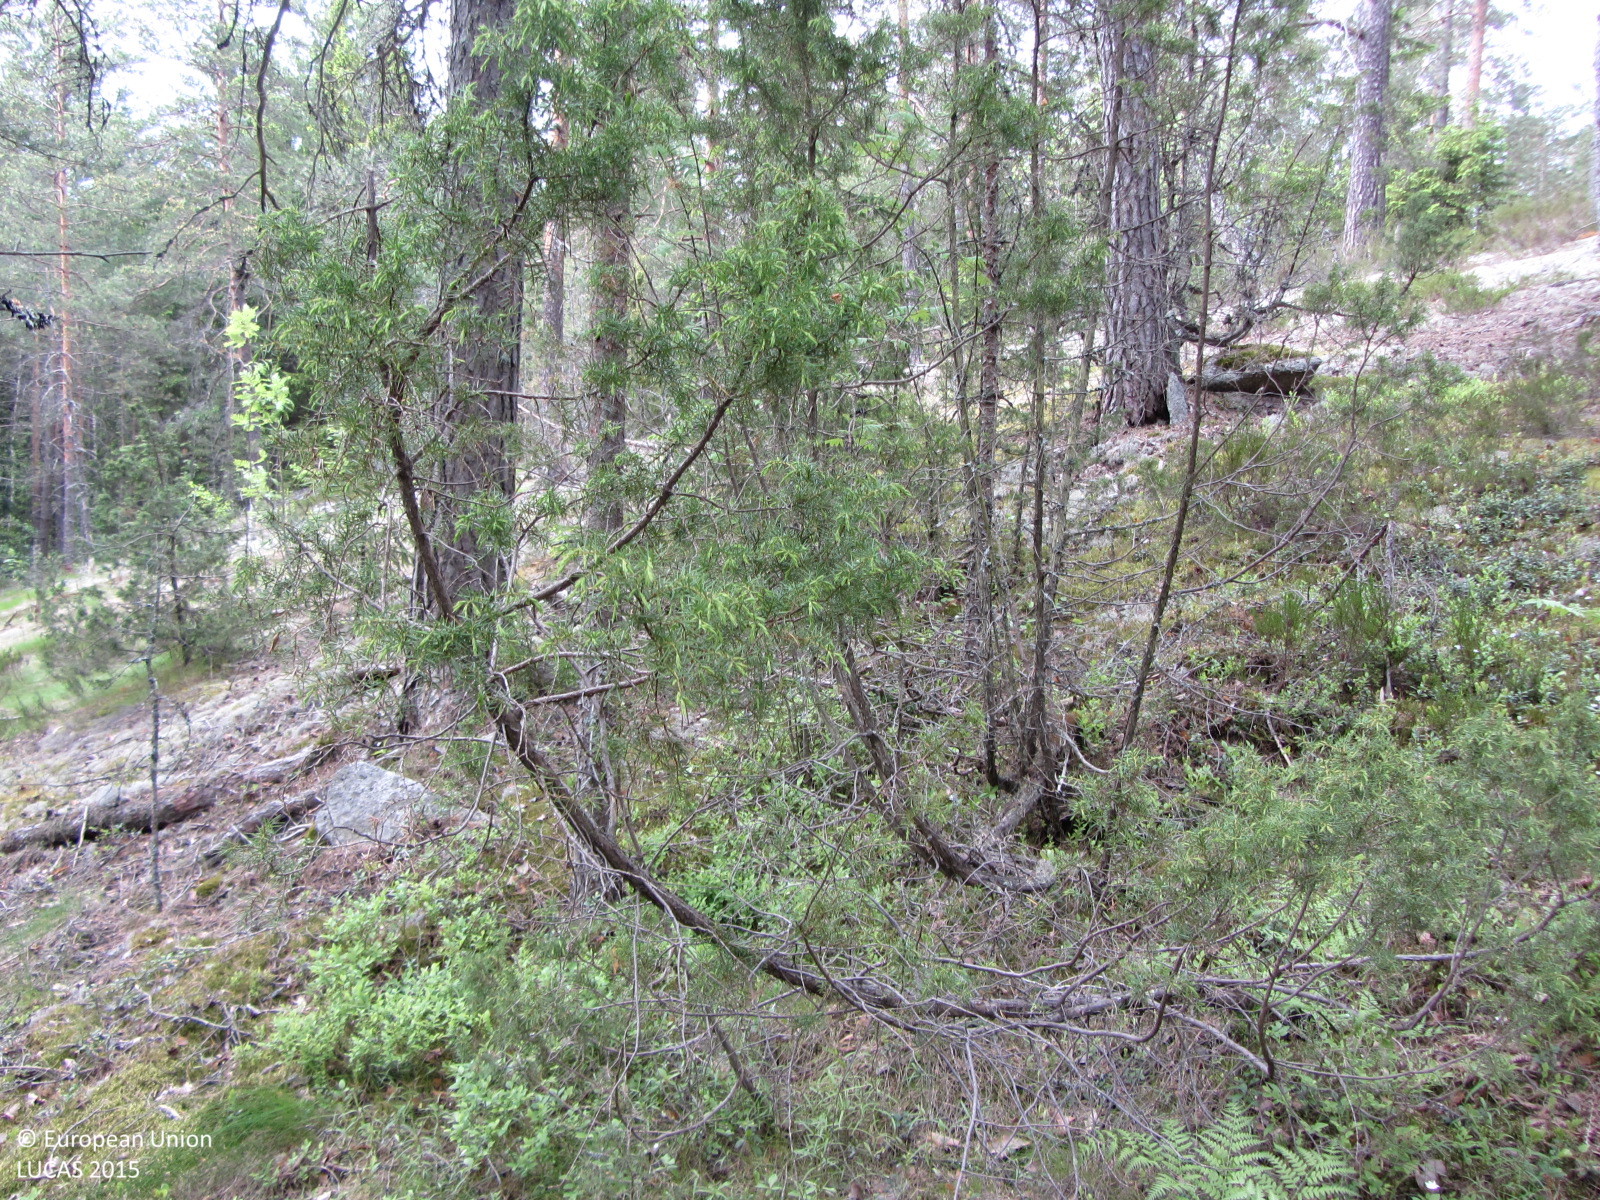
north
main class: Woodland
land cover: Pine dominated mixed woodland
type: boreal forest
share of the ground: > 75 %
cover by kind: coniferous forest trees 55 %, broadleaved forest trees 20 %, herbaceous plants 10 %, lichens and mosses 10 %, shrubs 5 %
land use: Semi-natural and natural areas not in use
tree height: > 5 m
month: June
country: FI
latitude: 60.2960
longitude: 24.6017
